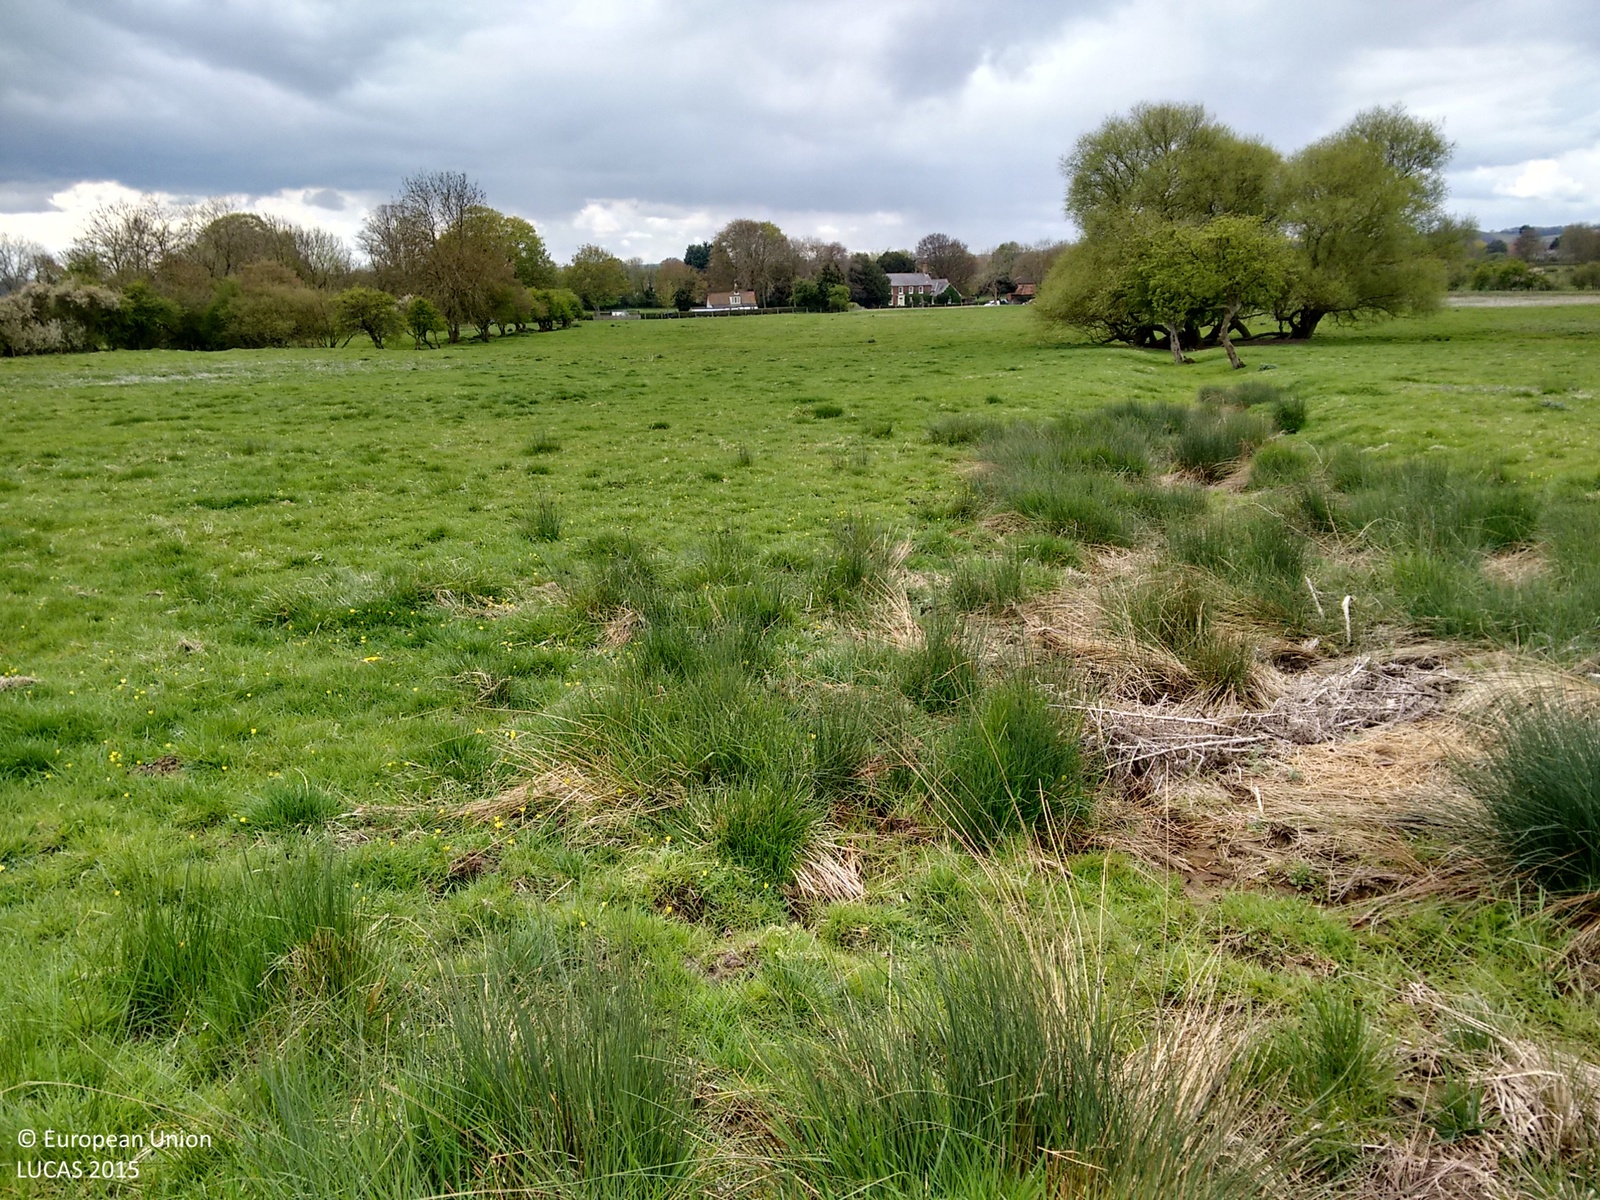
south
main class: Grassland
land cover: Grassland without tree/shrub cover
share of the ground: > 75 %
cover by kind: herbaceous plants 100 %
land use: Agriculture (excluding fallow land and kitchen gardens)
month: April
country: GB
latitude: 53.2588
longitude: -0.0006
